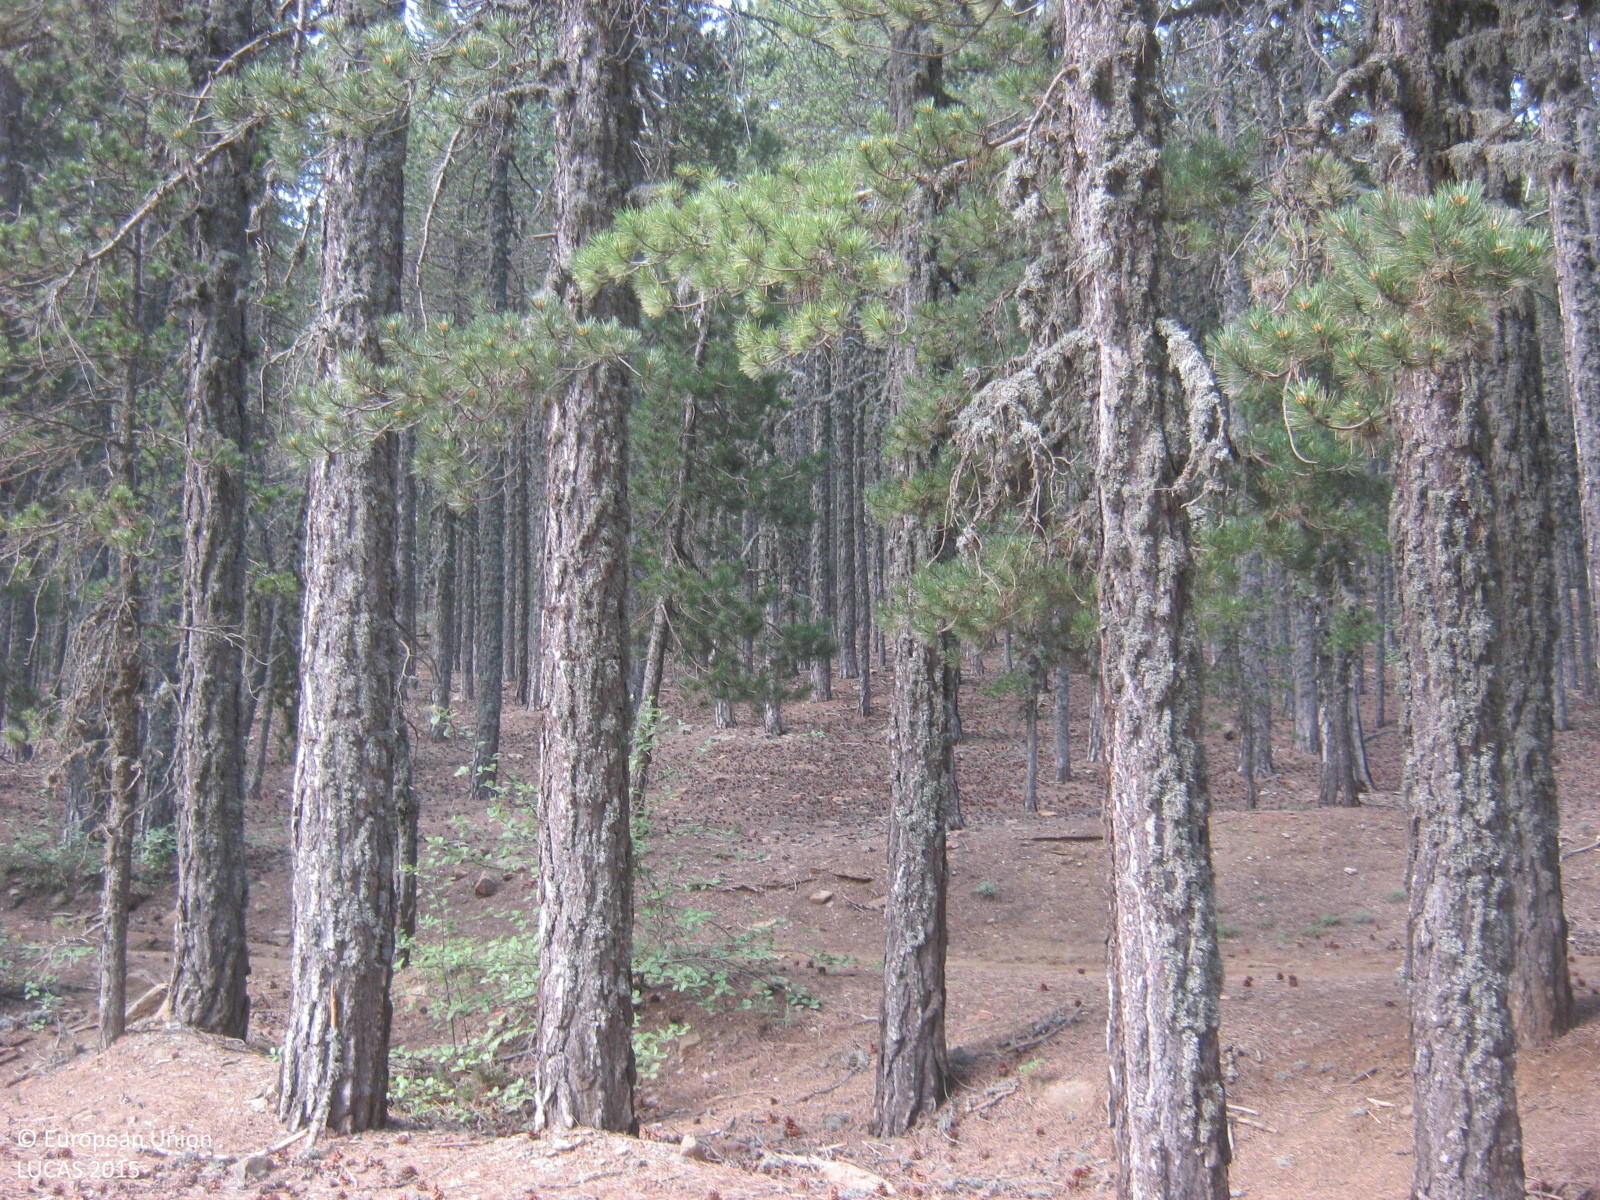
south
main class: Woodland
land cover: Pine dominated coniferous woodland
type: coniferous forest of the mediterranean region
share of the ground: > 75 %
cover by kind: coniferous forest trees 80 %, unconsolidated bare surface 15 %, shrubs 5 %
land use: Forestry
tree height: > 5 m
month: June
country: CY
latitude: 34.9412
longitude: 32.8638
